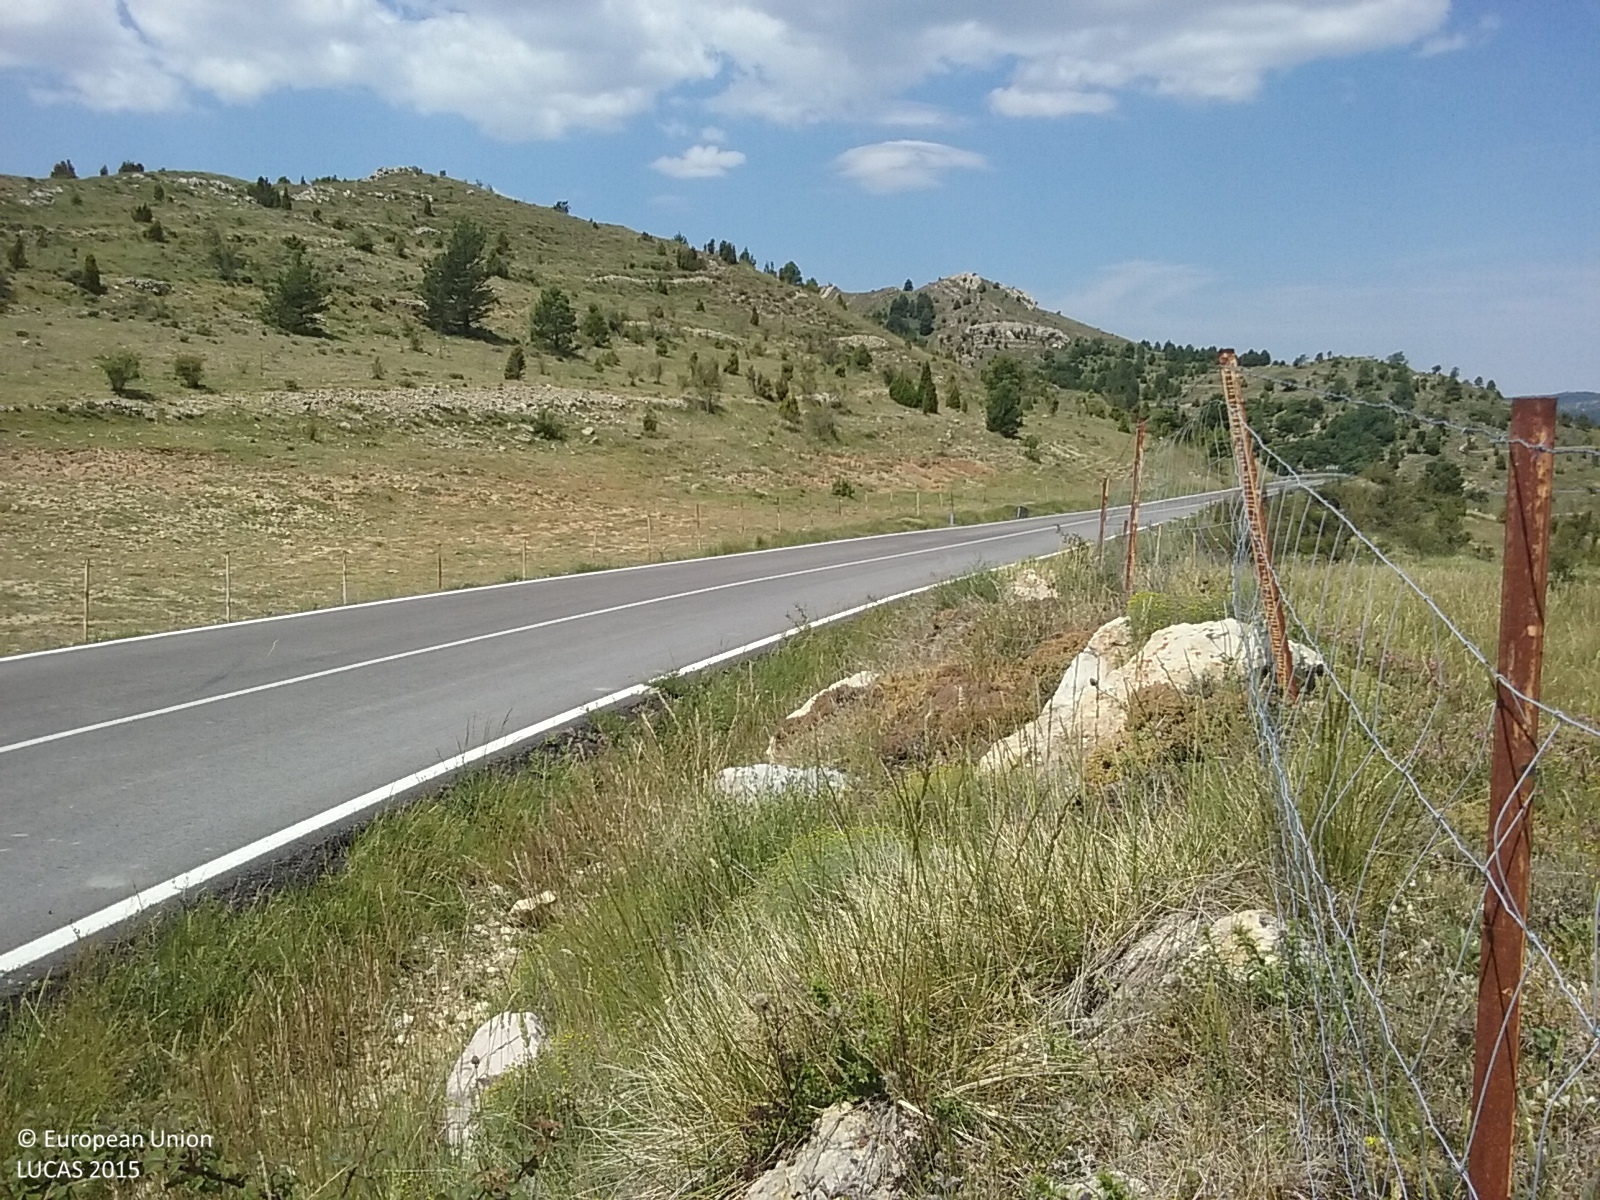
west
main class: Shrubland
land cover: Shrubland with sparse tree cover
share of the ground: 25 - 50 %
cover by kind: unconsolidated bare surface 65 %, shrubs 20 %, herbaceous plants 10 %, coniferous forest trees 5 %
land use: Semi-natural and natural areas not in use
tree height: < 5 m
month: June
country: ES
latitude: 40.6501
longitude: 0.0236
